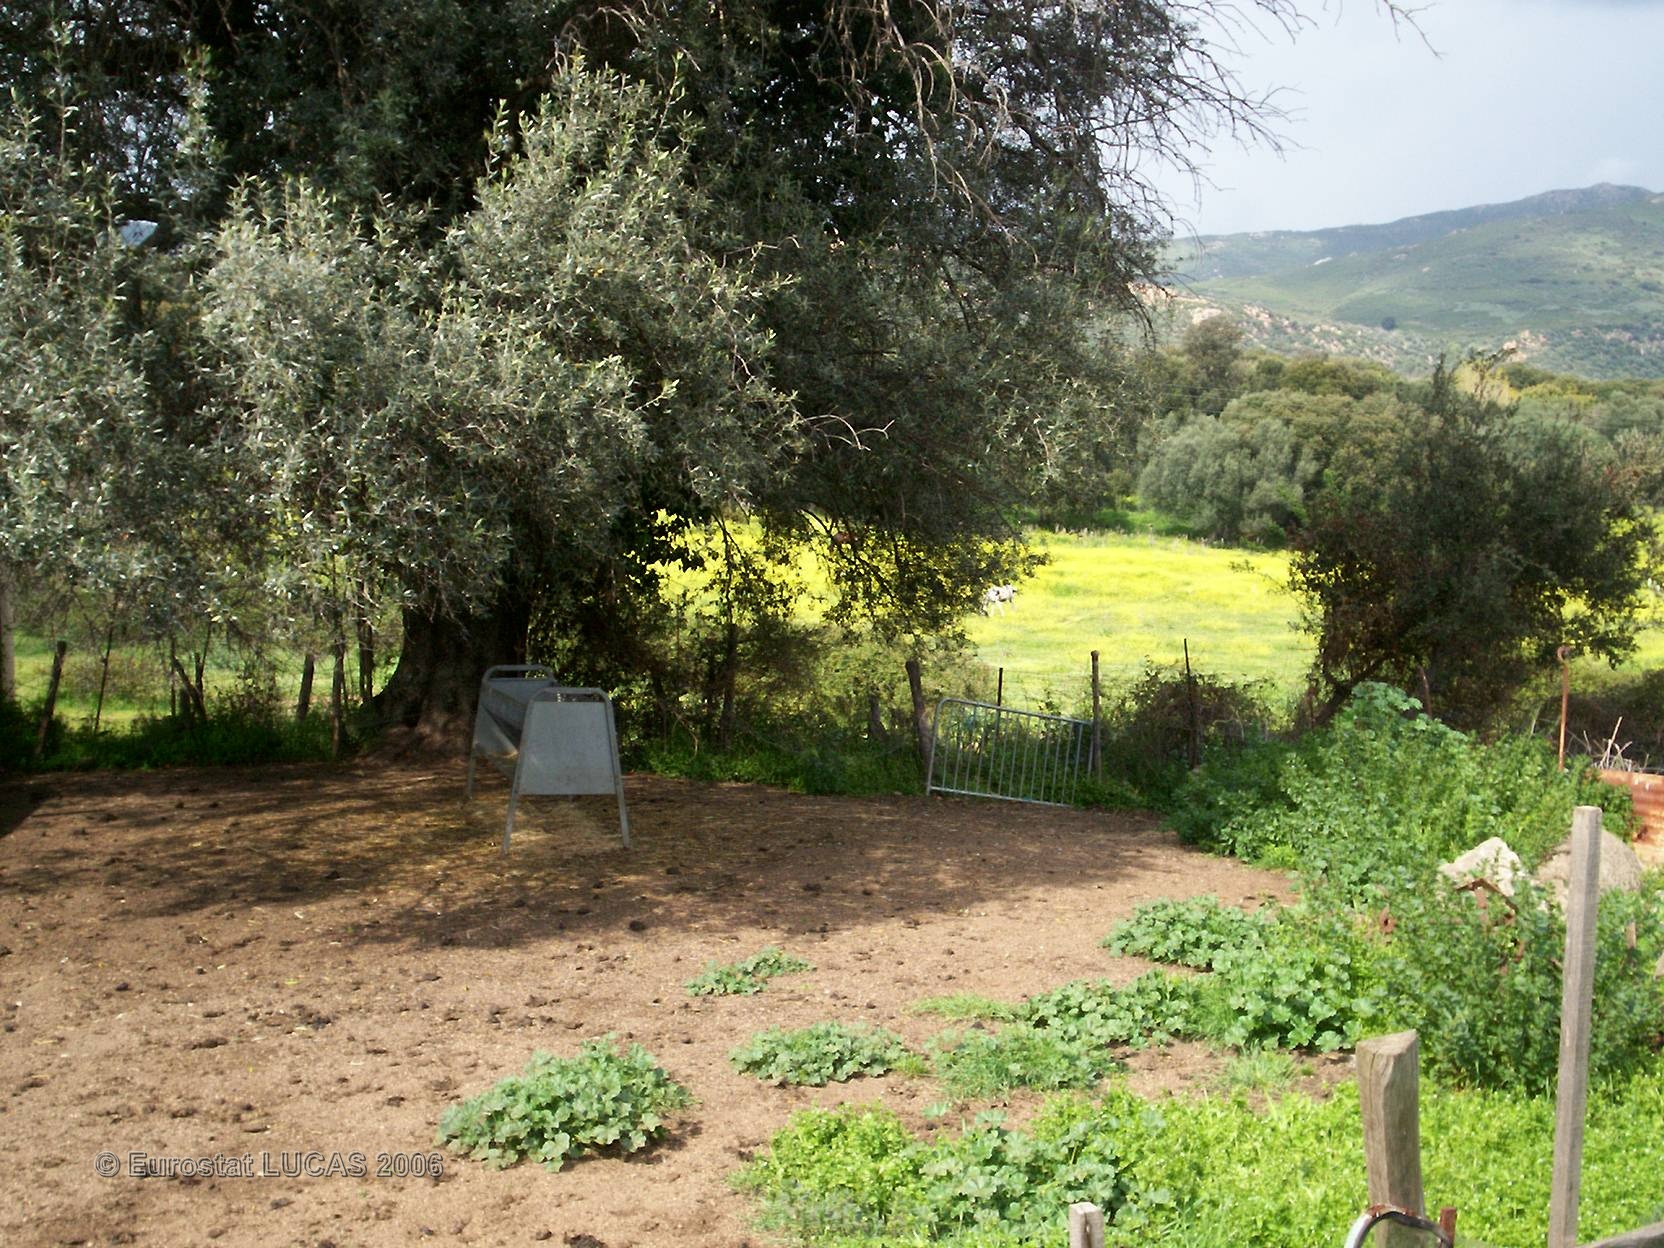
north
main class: Grassland
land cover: Grassland without tree/shrub cover
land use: Agriculture (excluding fallow land and kitchen gardens)
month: April
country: FR
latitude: 41.9960
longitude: 8.7613
